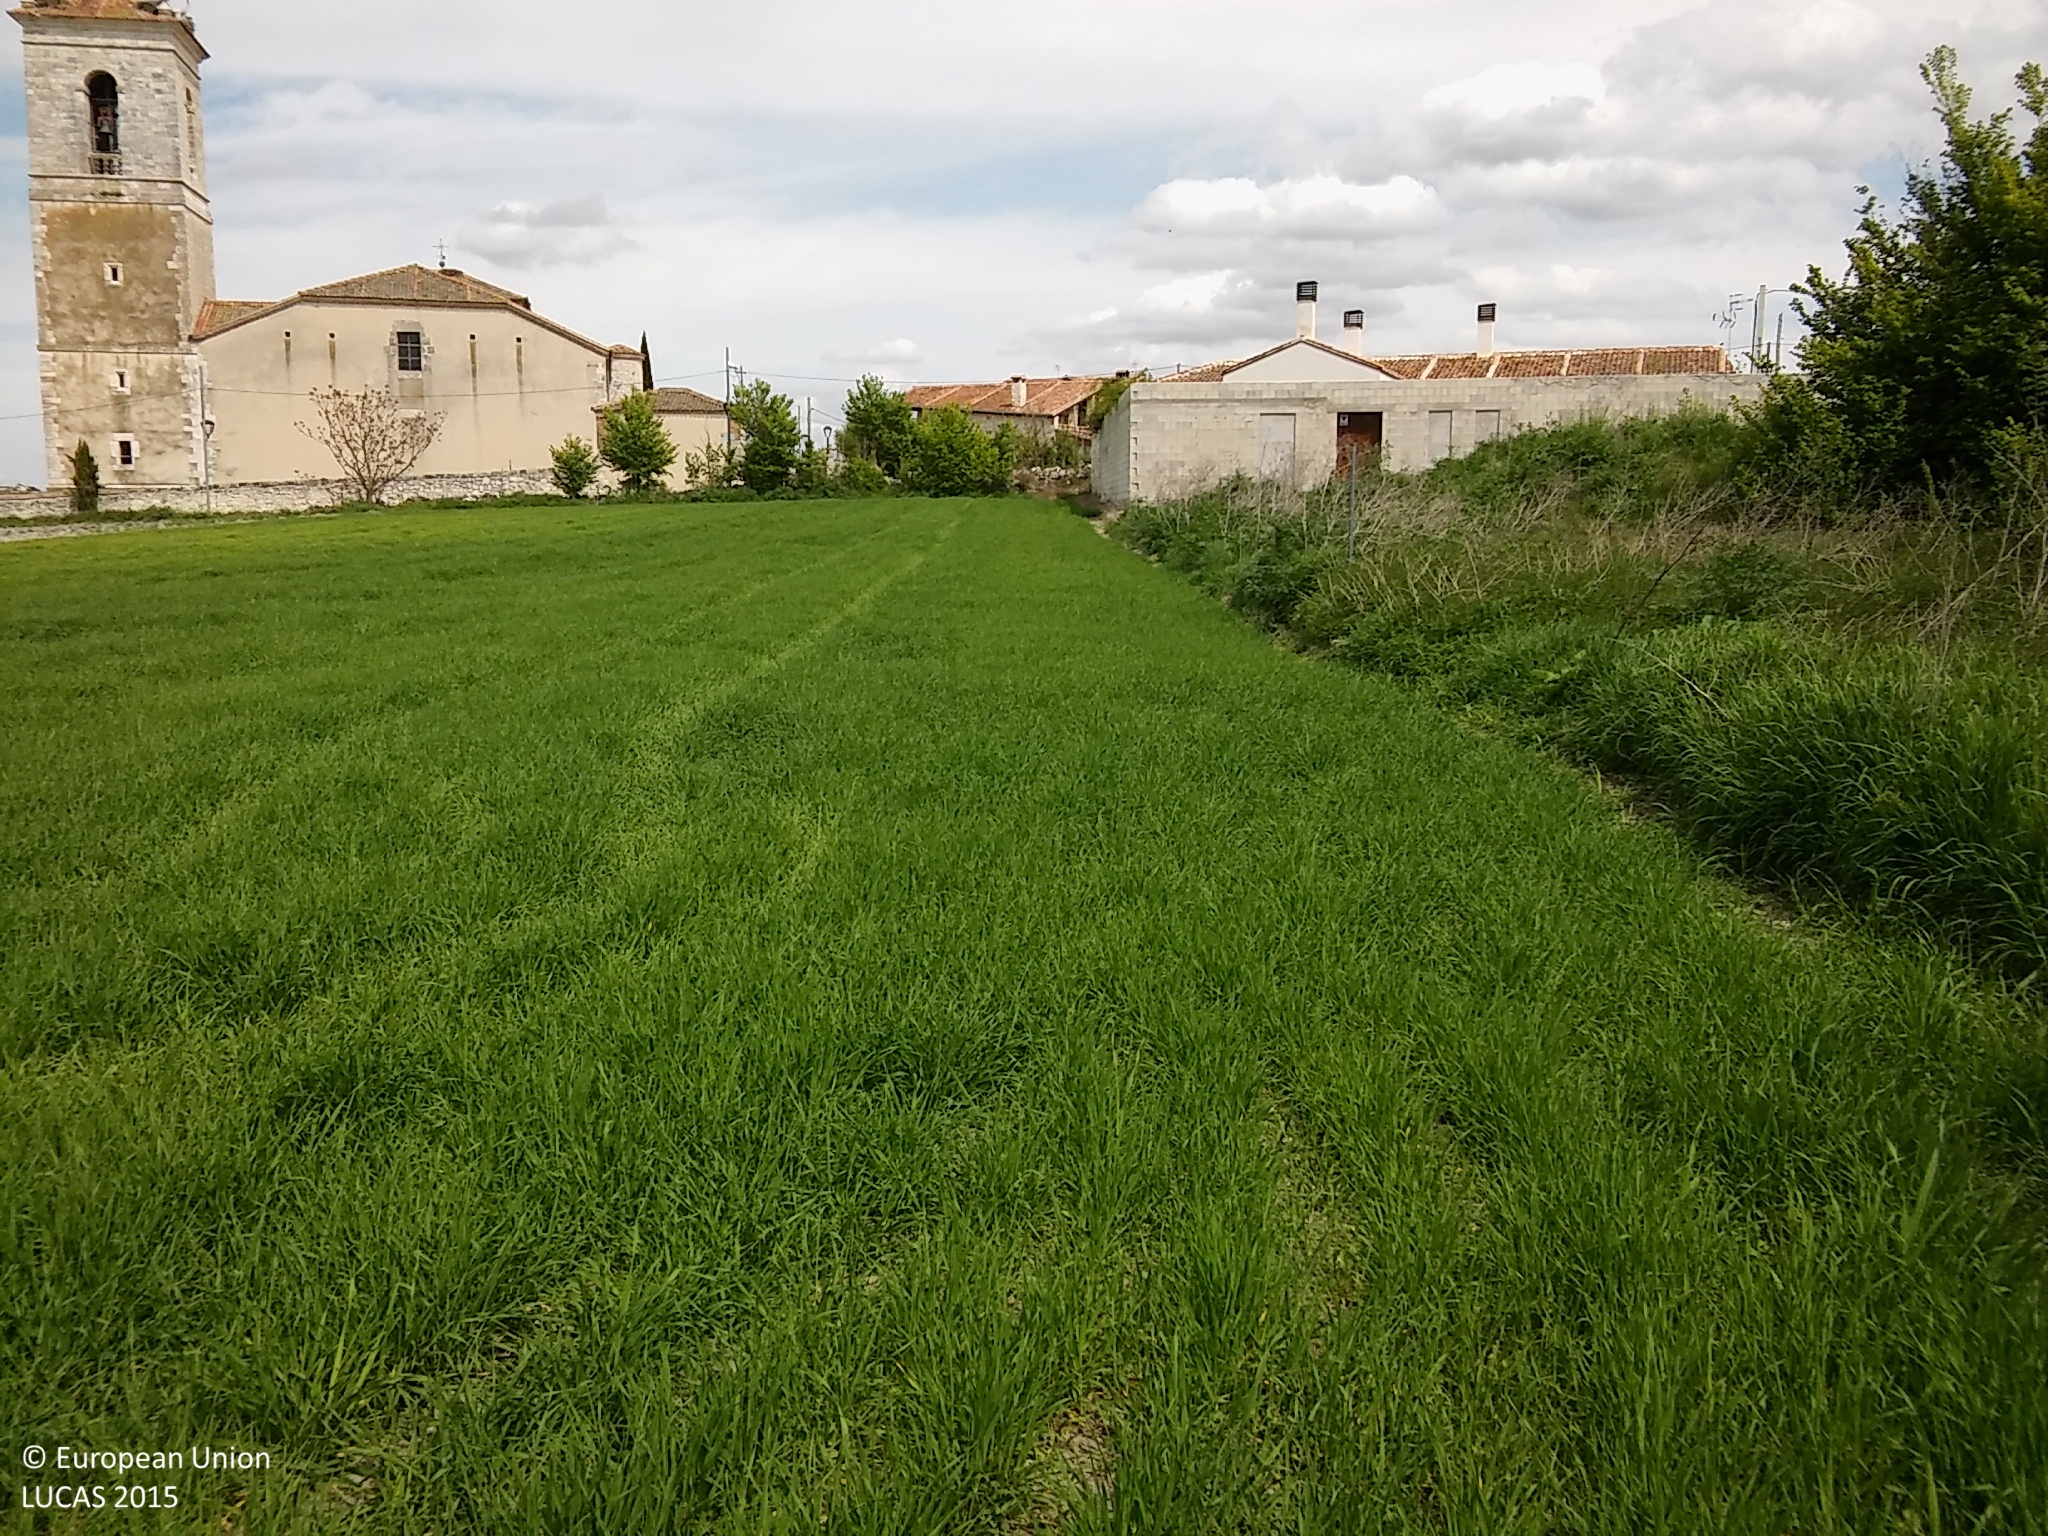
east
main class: Cropland
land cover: Barley
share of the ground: 50 - 75 %
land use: Agriculture (excluding fallow land and kitchen gardens)
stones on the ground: 10 - 25 %
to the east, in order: Barley; Dry stone walls; Tracks; Dry stone walls; Groves; Spontaneously vegetated surfaces; Artificial constructions in urban areas; Tracks; Grassland without tree/shrub cover
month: April
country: ES
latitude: 41.3476
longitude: -4.1223
